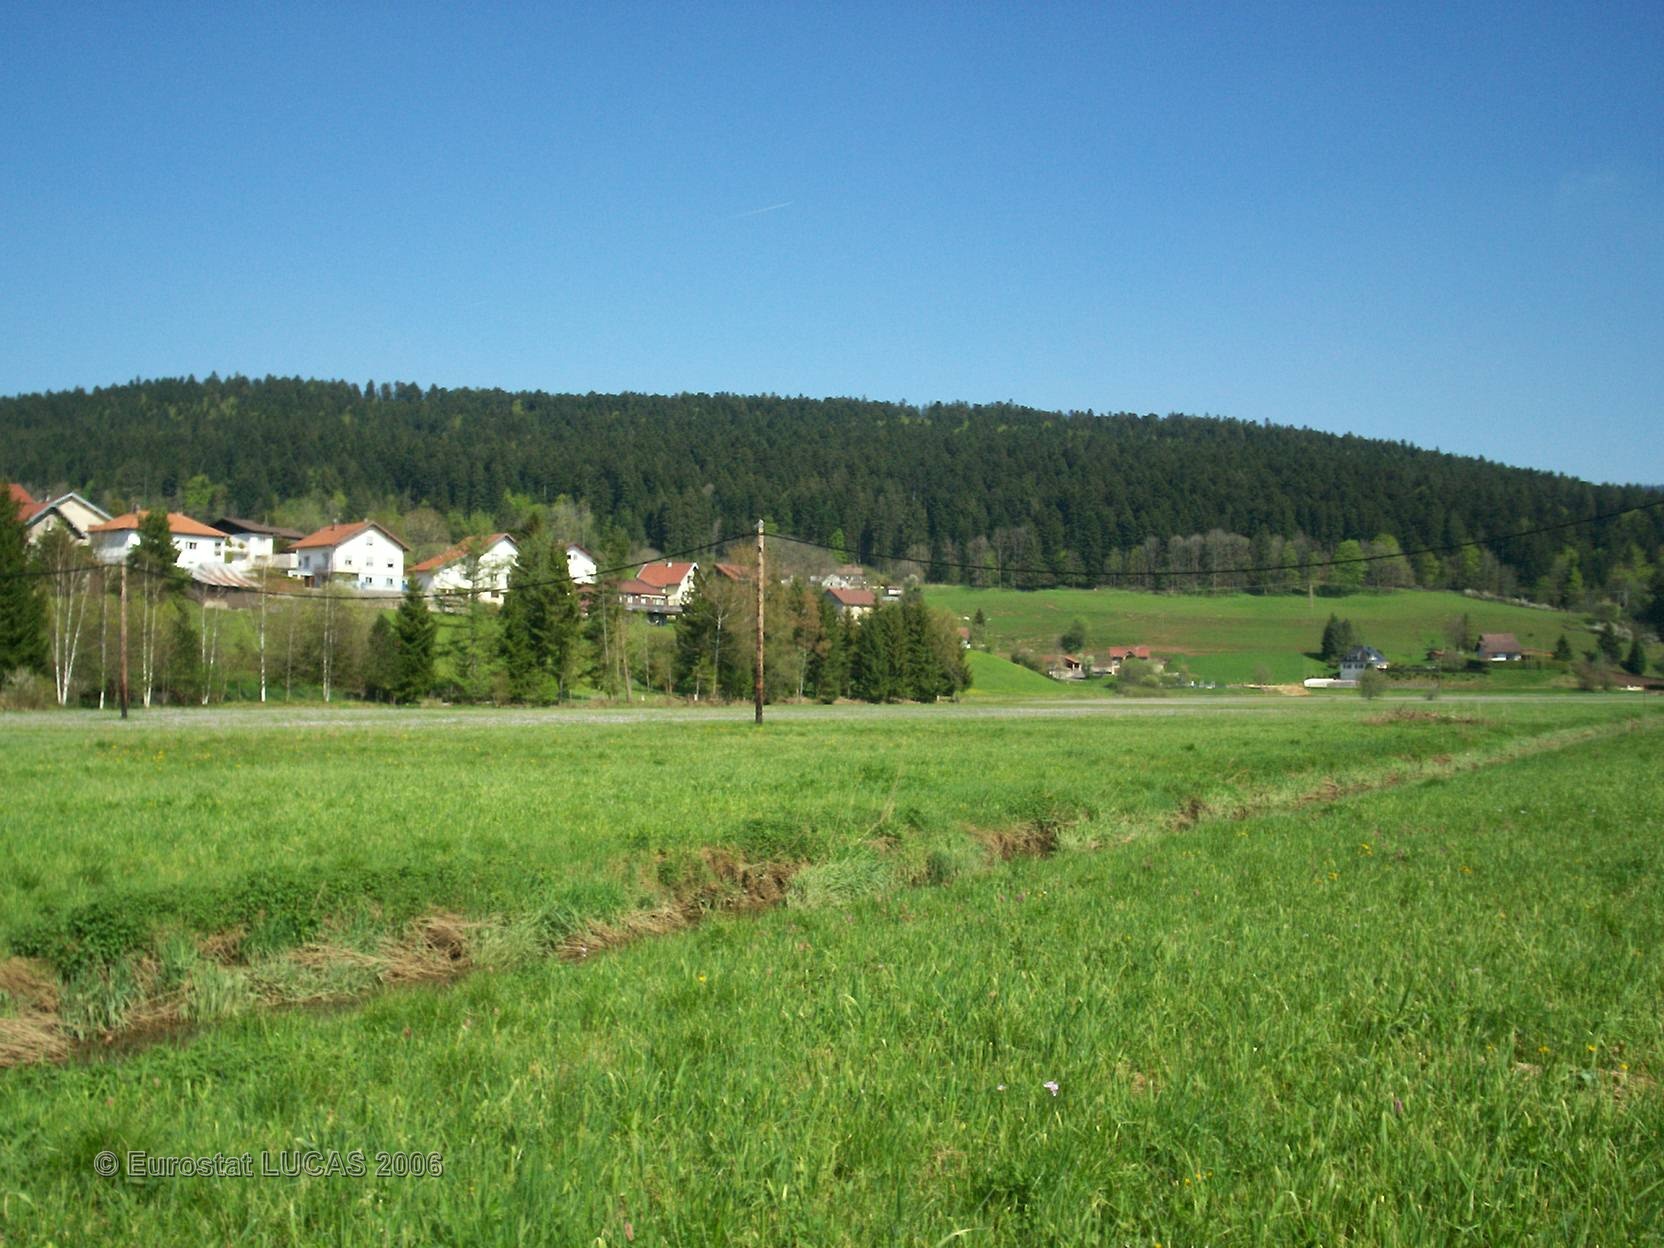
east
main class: Grassland
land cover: Grassland without tree/shrub cover
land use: Wetland
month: May
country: FR
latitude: 47.0548
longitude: 6.6189
